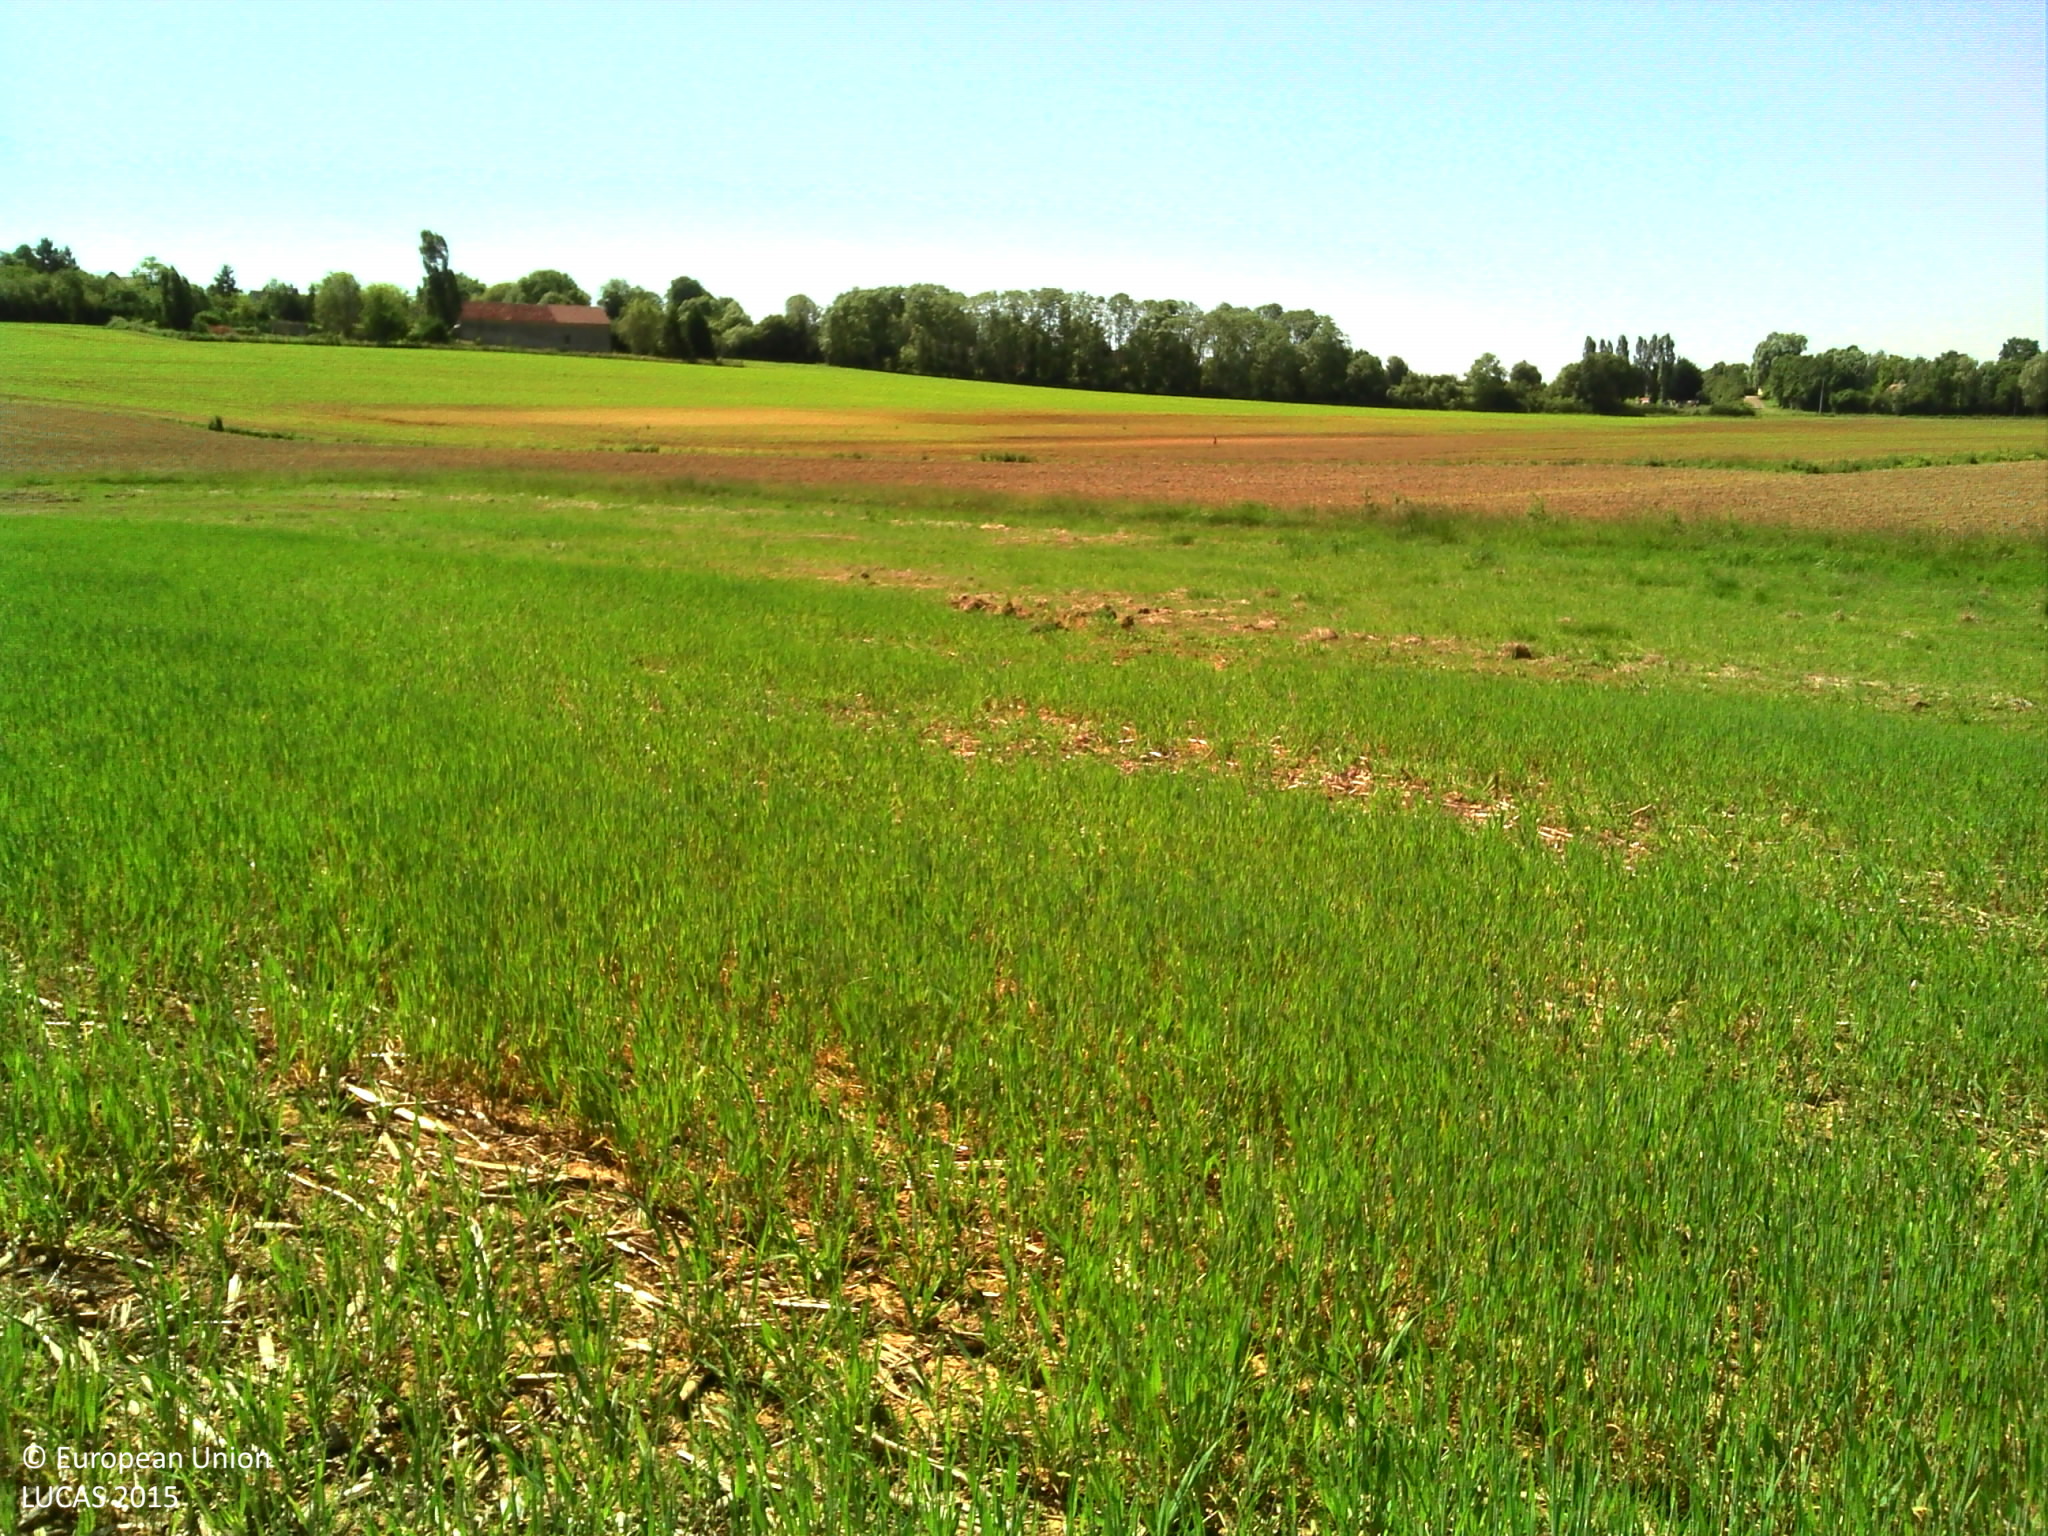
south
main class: Cropland
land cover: Barley
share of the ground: > 75 %
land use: Agriculture (excluding fallow land and kitchen gardens)
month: June
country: FR
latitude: 47.0192
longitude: 2.9042
